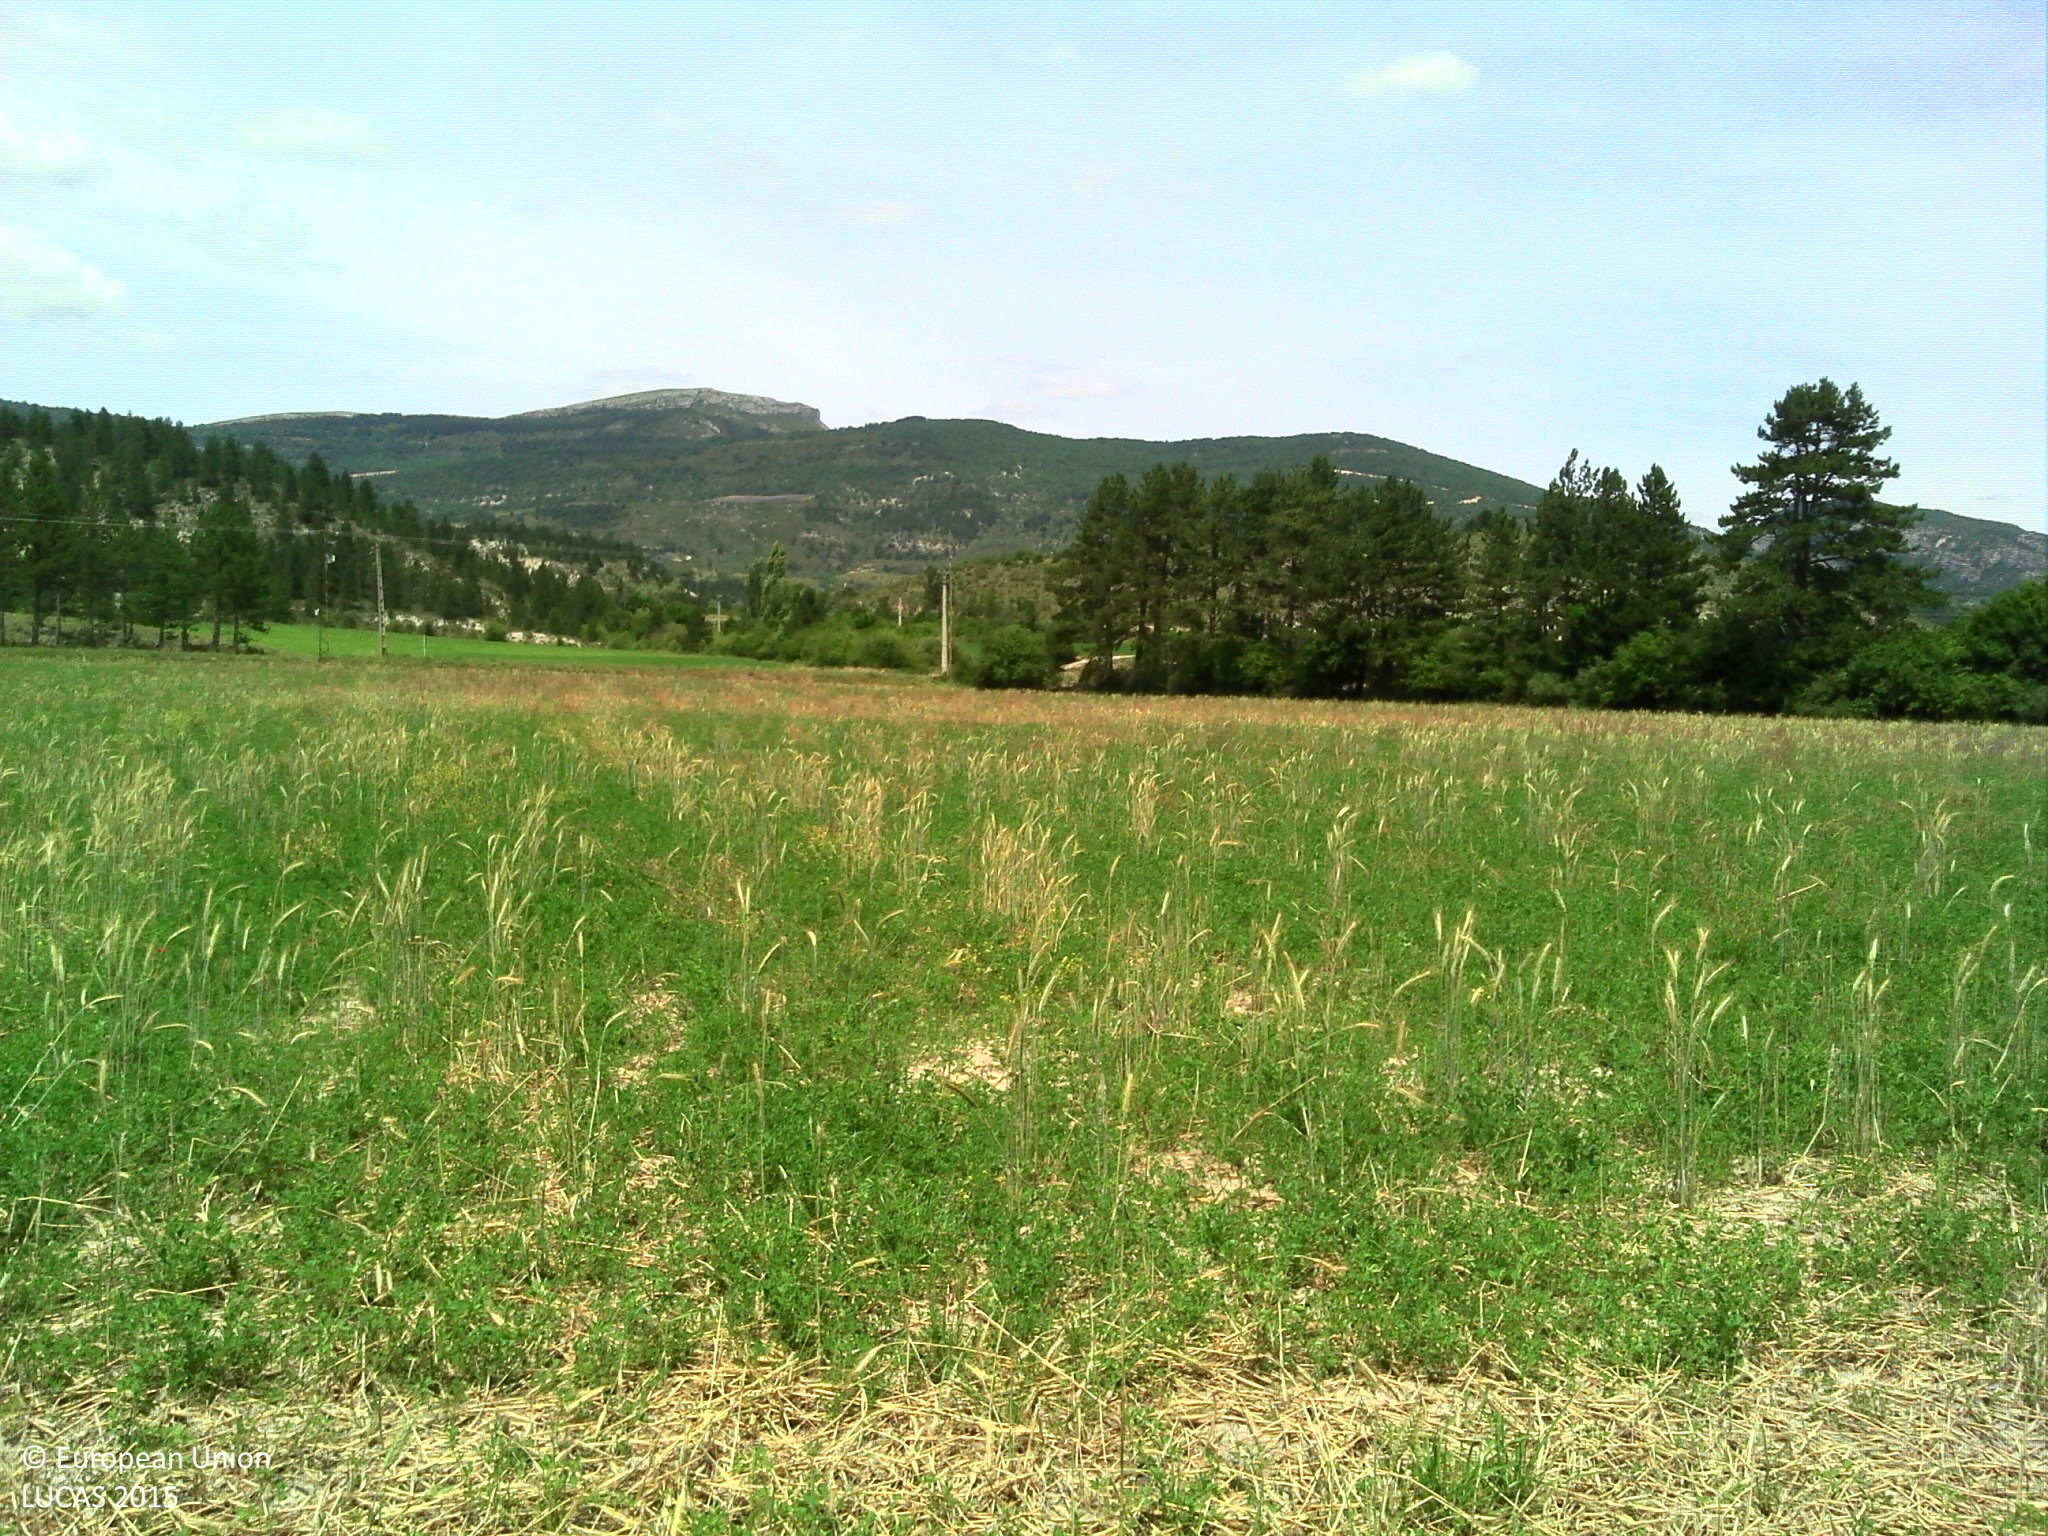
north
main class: Cropland
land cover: Mixed cereals for fodder
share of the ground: > 75 %
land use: Agriculture (excluding fallow land and kitchen gardens)
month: June
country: FR
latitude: 44.2196
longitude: 5.5641
